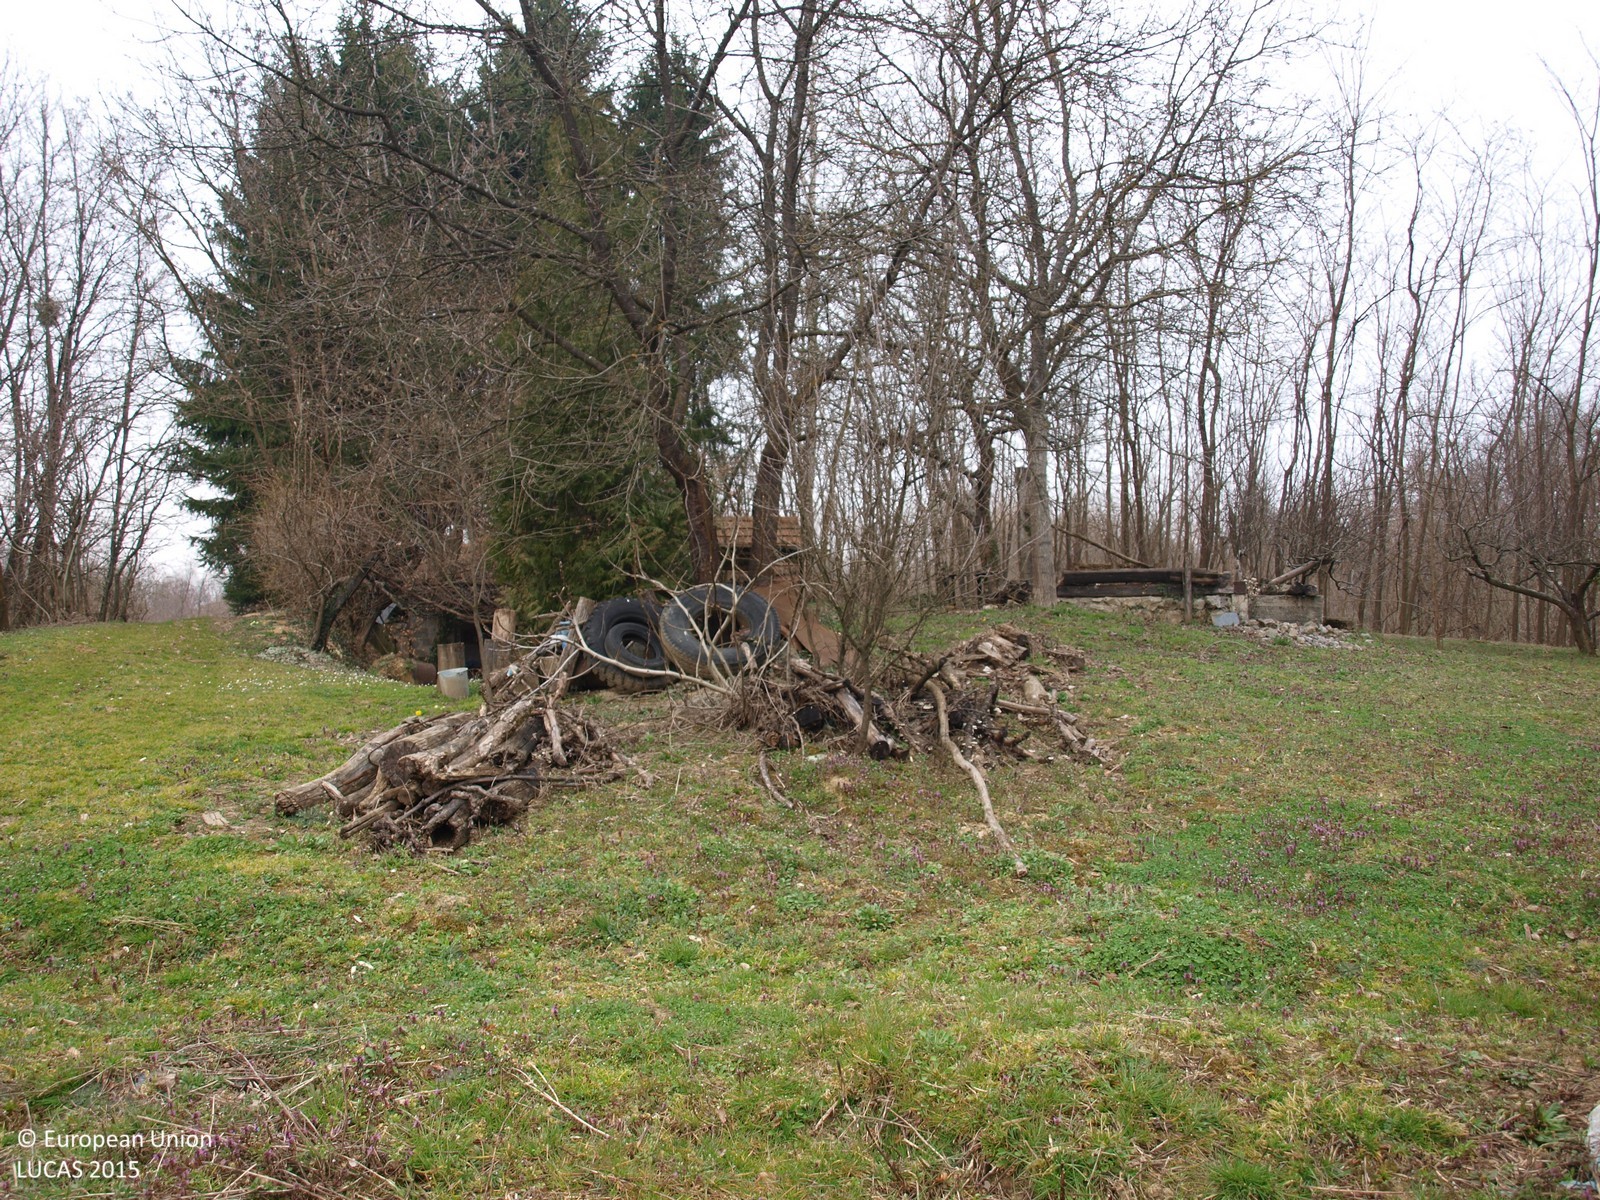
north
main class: Grassland
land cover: Grassland without tree/shrub cover
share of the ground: > 75 %
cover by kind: herbaceous plants 100 %
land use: Agriculture (excluding fallow land and kitchen gardens)
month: March
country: HR
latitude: 46.2264
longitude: 16.1840
